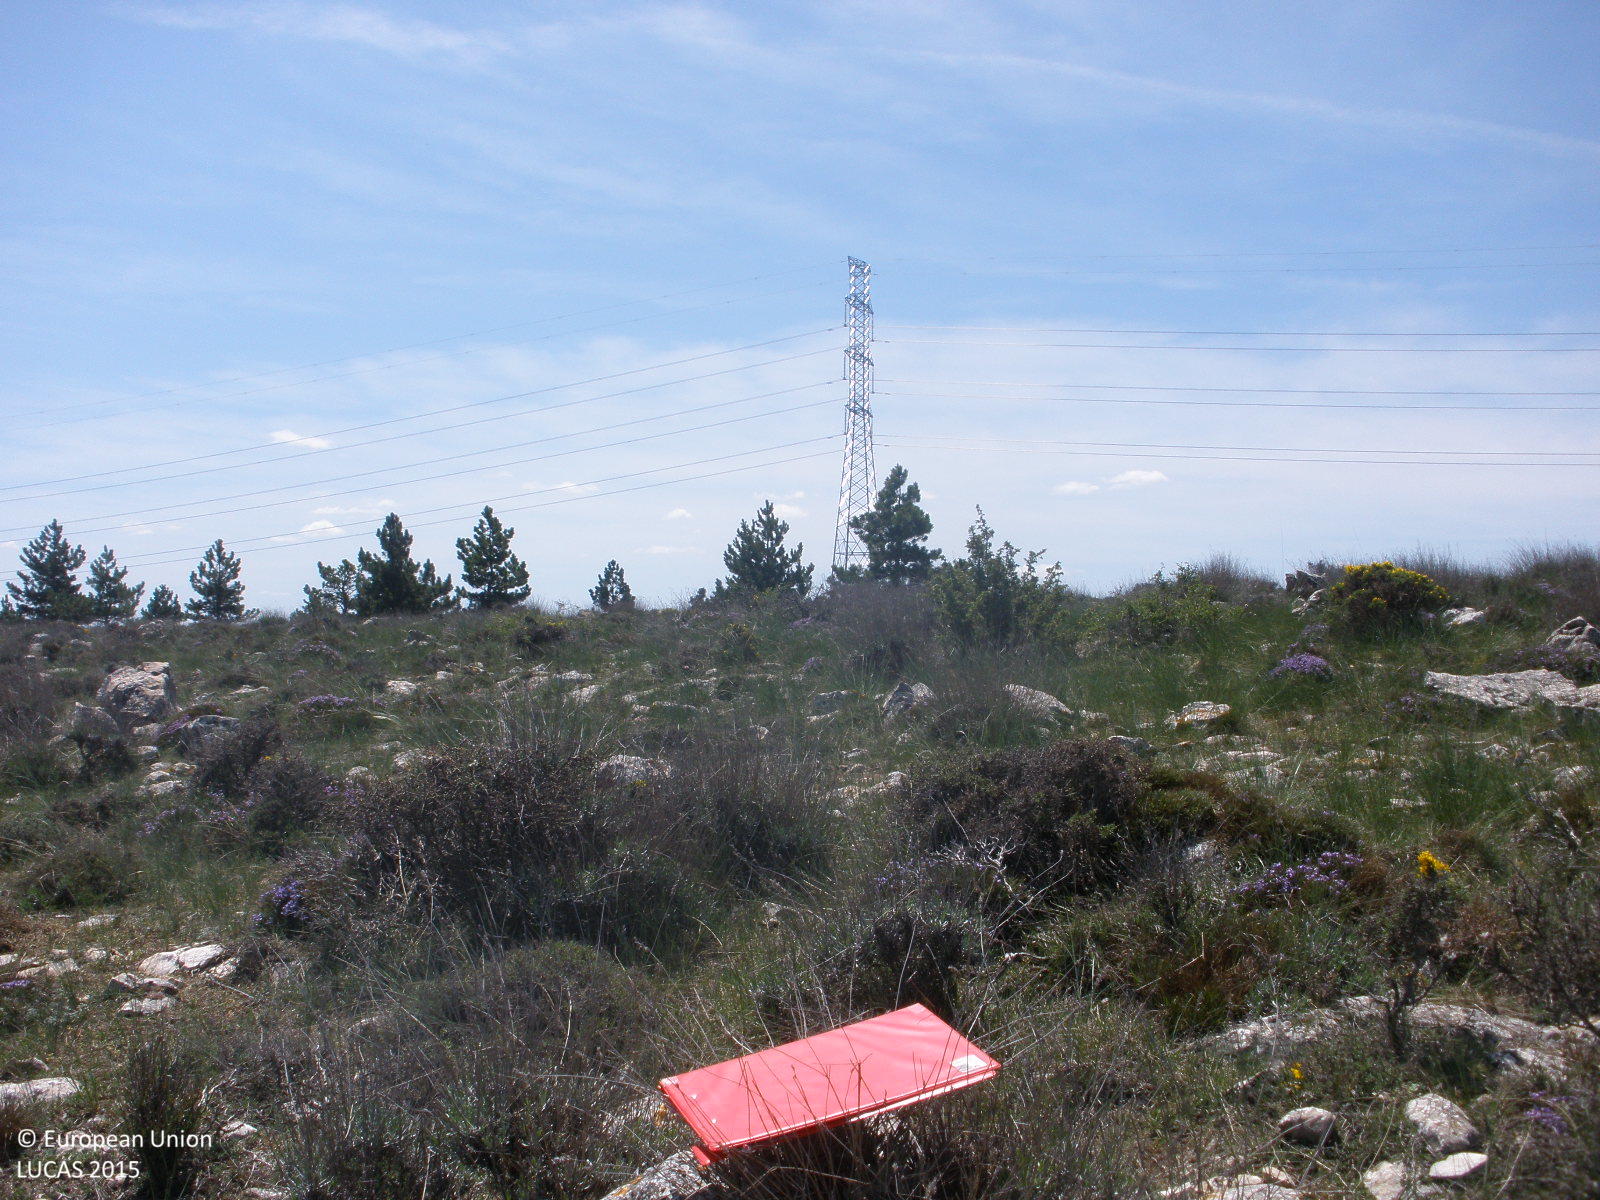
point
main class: Shrubland
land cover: Shrubland without tree cover
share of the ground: 50 - 75 %
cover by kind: shrubs 60 %, herbaceous plants 35 %, consolidated bare surface 5 %
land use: Semi-natural and natural areas not in use
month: May
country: ES
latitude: 40.8209
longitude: -1.1013
